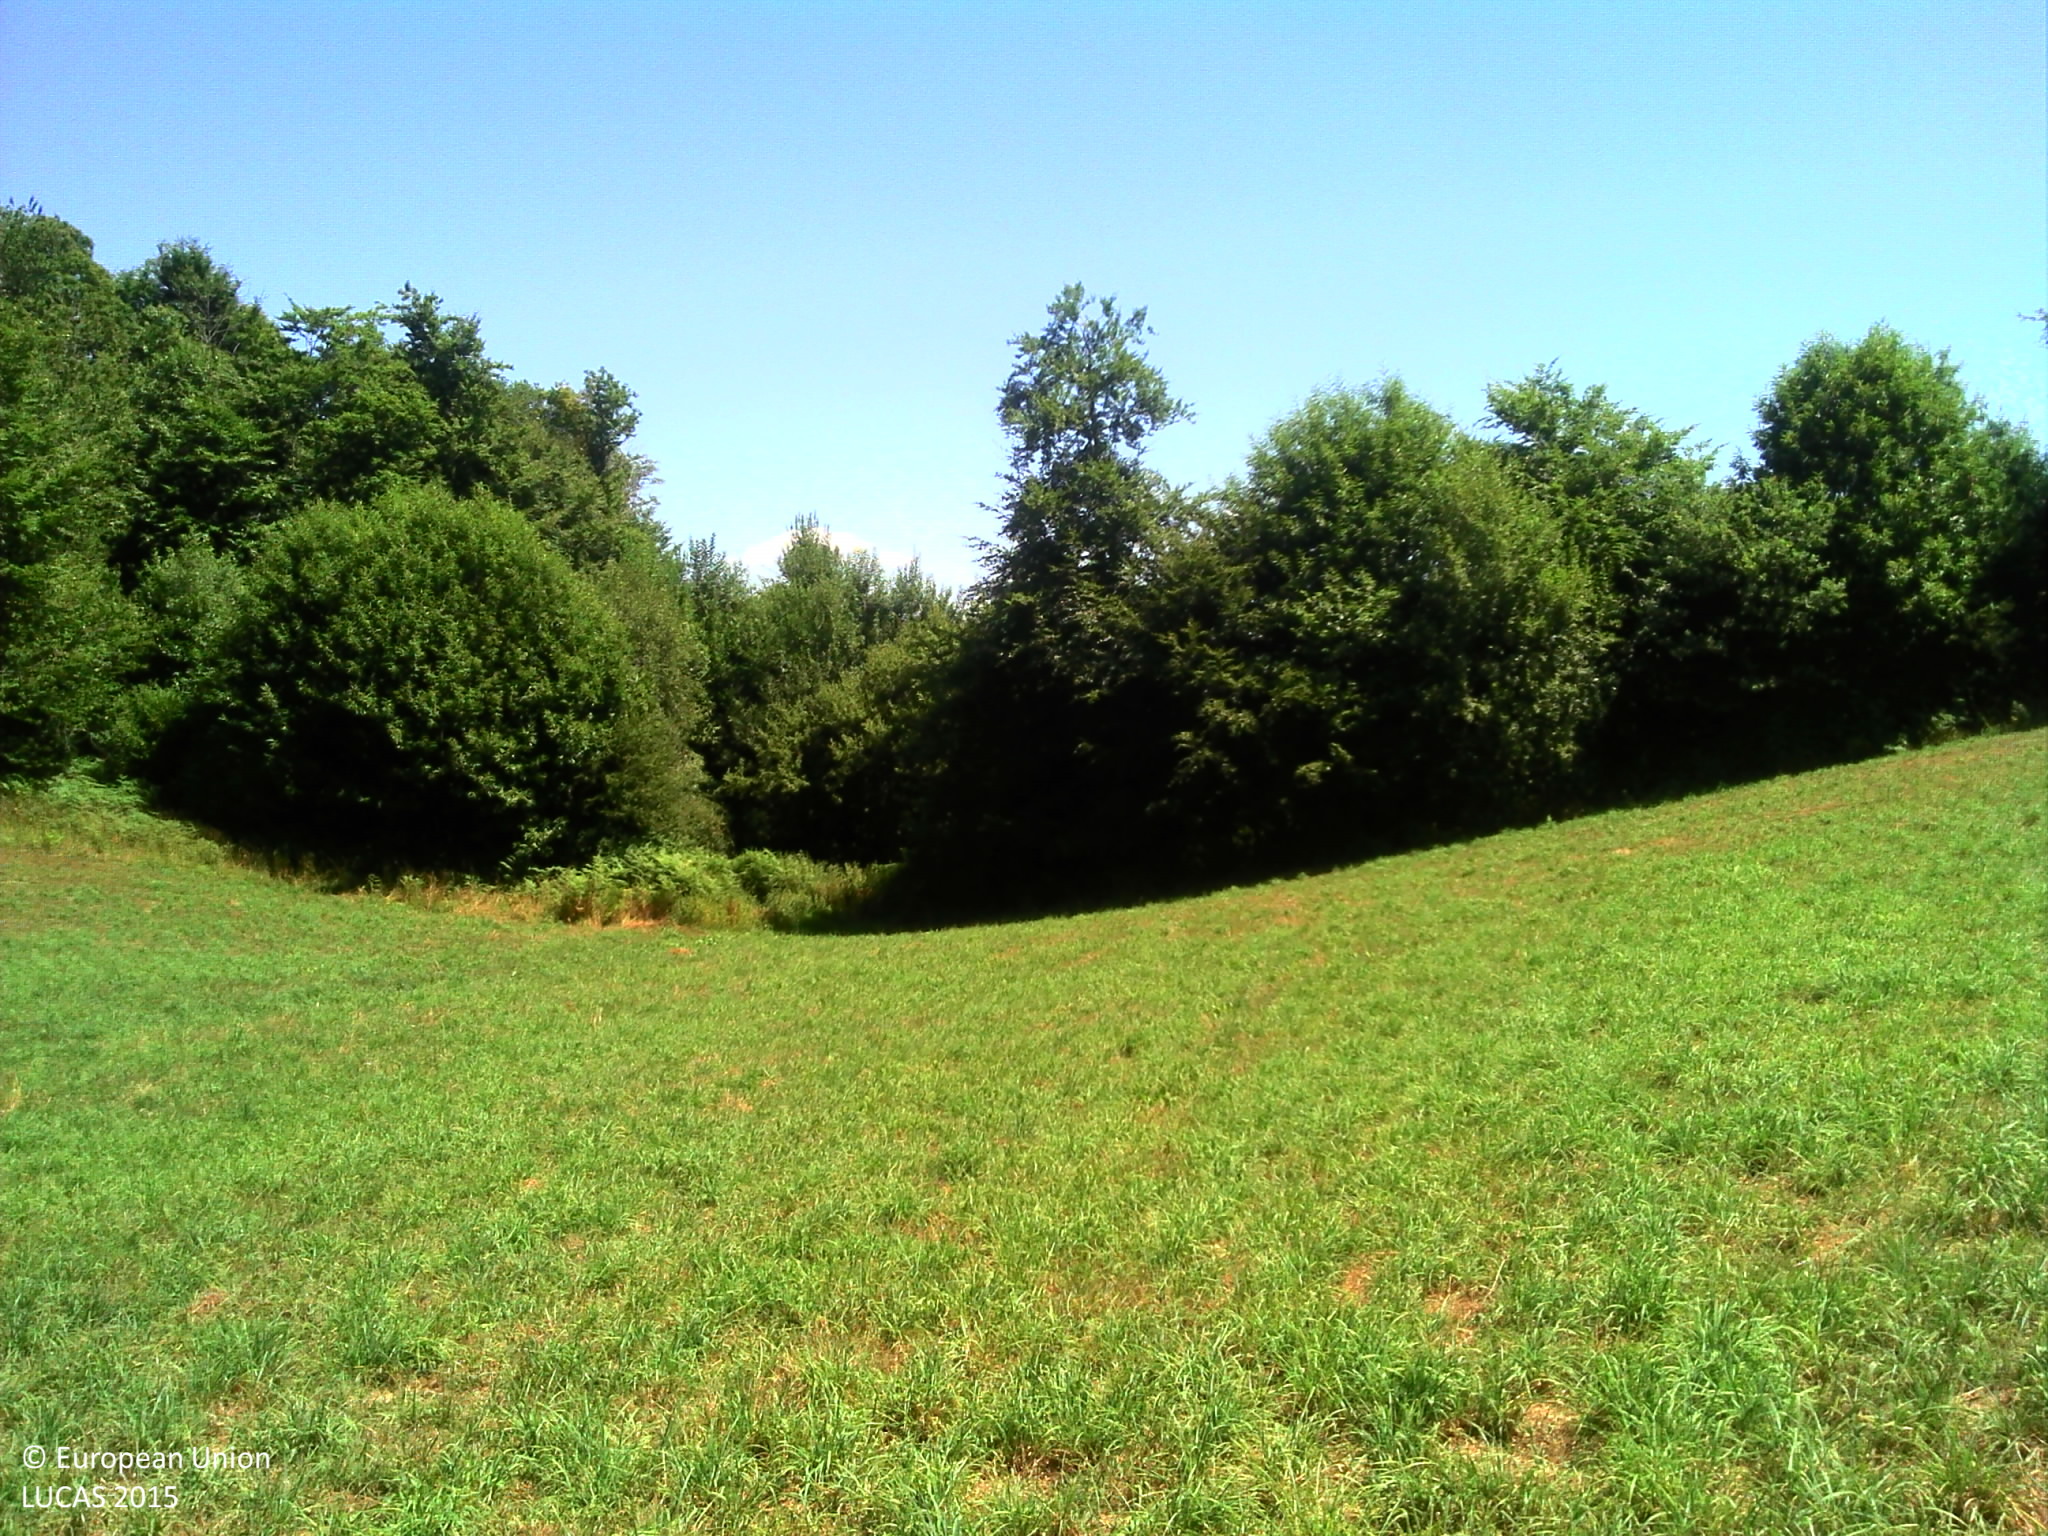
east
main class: Grassland
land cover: Grassland without tree/shrub cover
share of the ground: > 75 %
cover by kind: herbaceous plants 95 %
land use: Agriculture (excluding fallow land and kitchen gardens)
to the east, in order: Grassland without tree/shrub cover; Broadleaved woodland; Grassland without tree/shrub cover; Fences; Grassland without tree/shrub cover
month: July
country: FR
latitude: 45.6255
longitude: 1.6441
